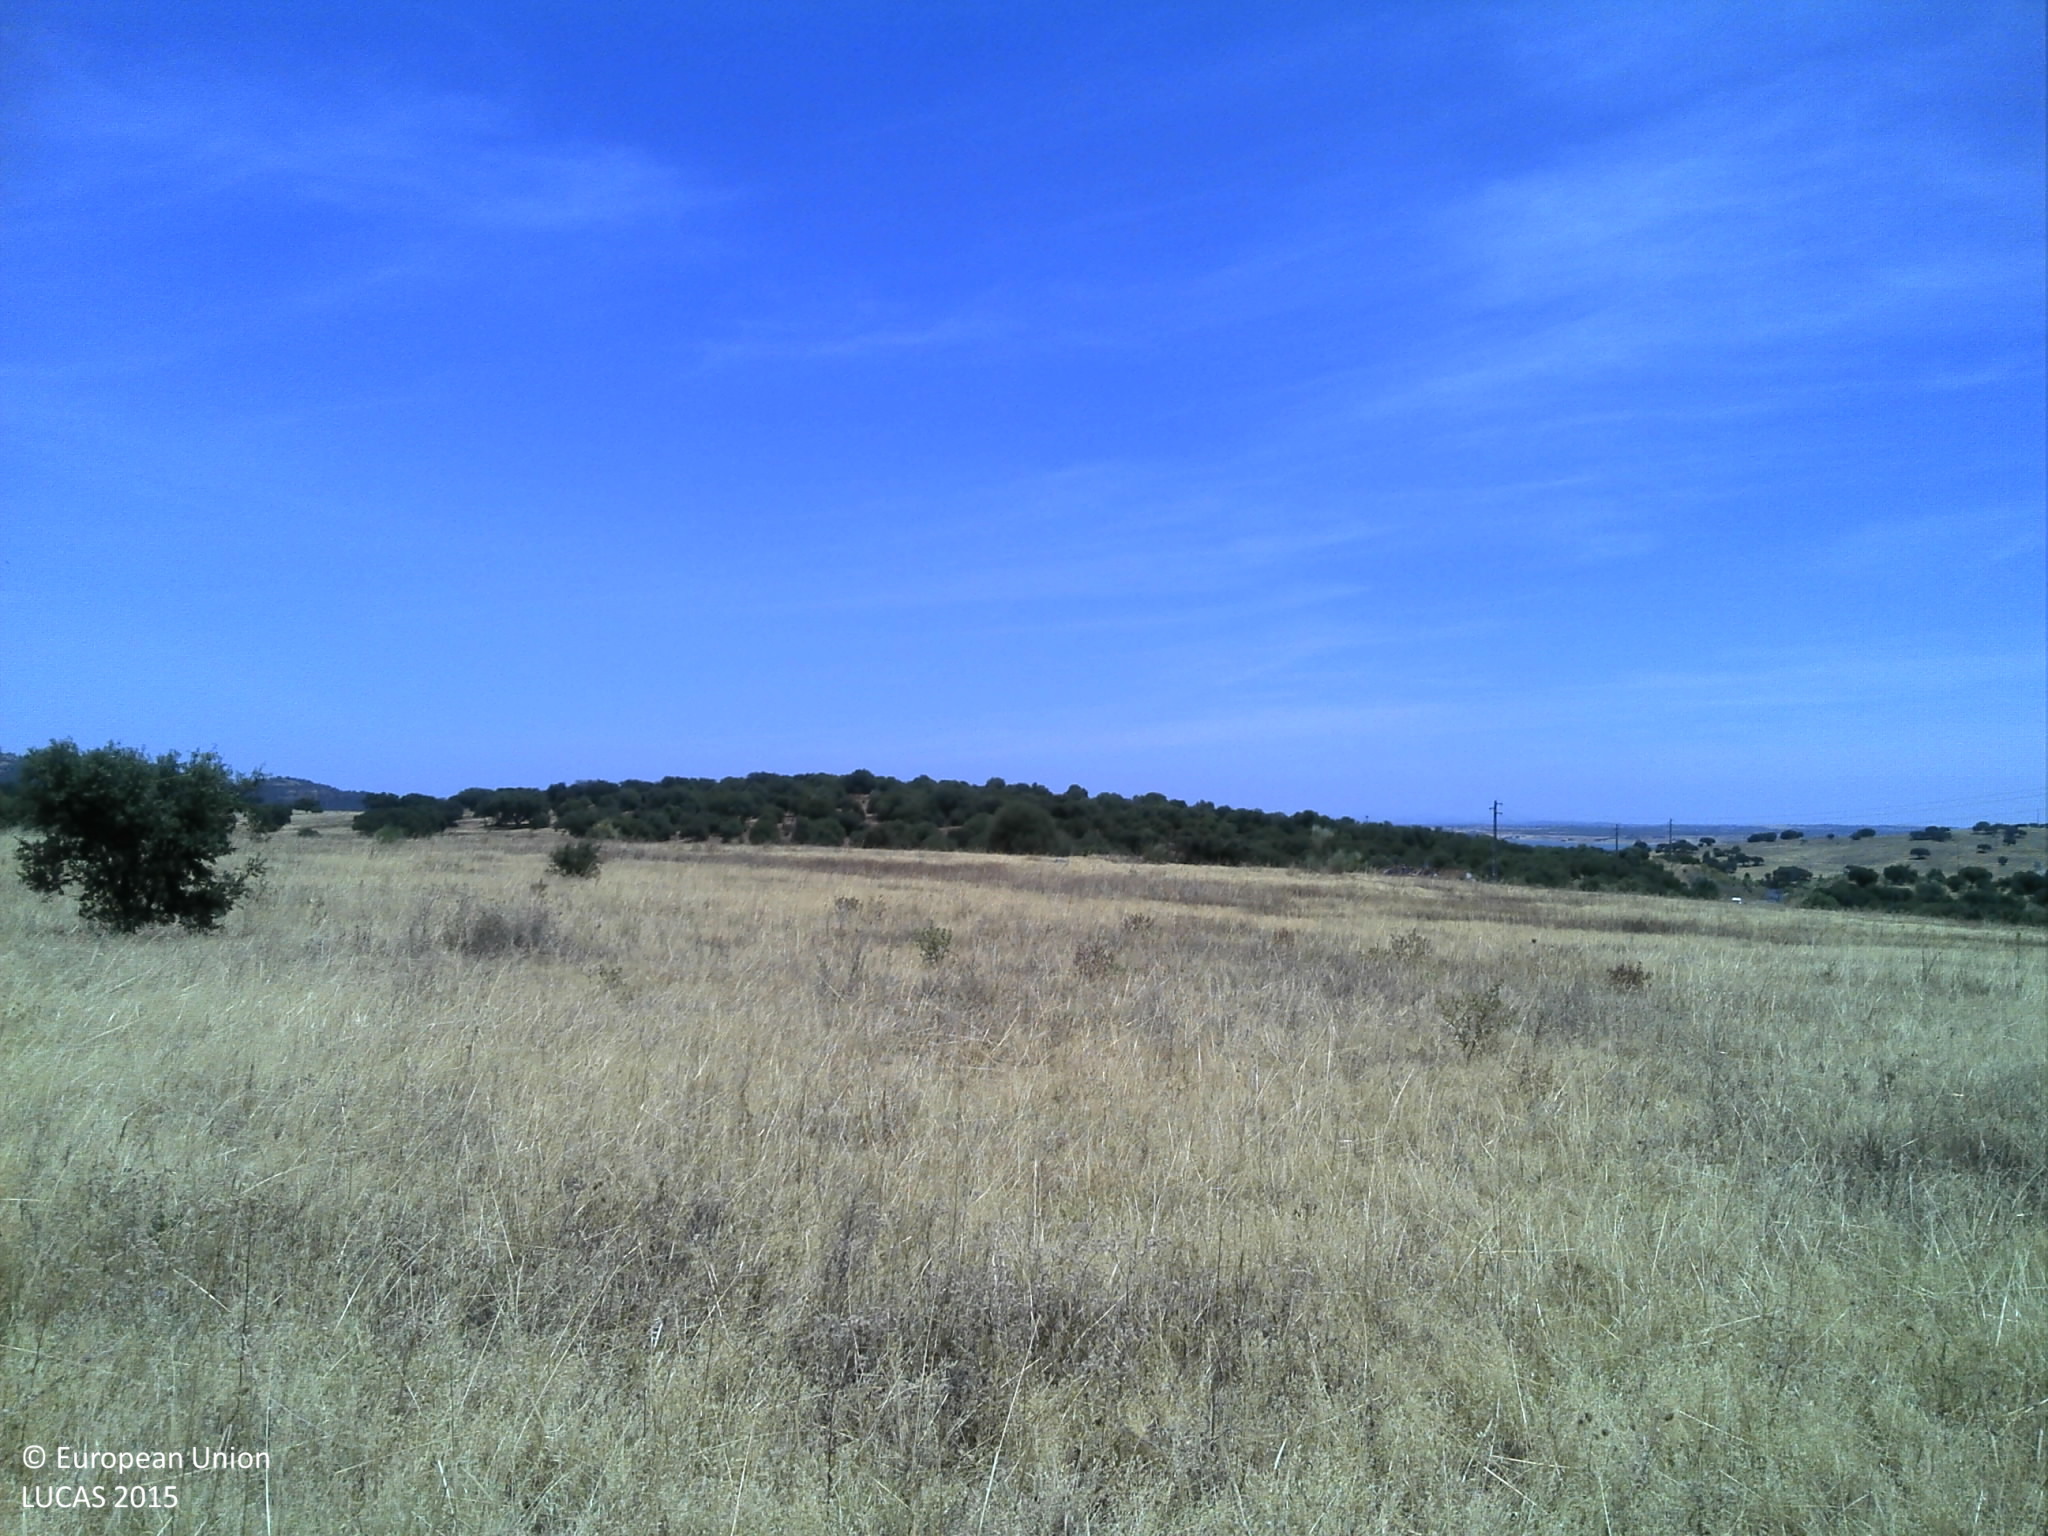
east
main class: Grassland
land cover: Grassland without tree/shrub cover
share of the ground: 25 - 50 %
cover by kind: herbaceous plants 50 %, unconsolidated bare surface 50 %
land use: Agriculture (excluding fallow land and kitchen gardens)
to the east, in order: Grassland without tree/shrub cover; Single bushes/trees
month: July
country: PT
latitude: 38.4178
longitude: -7.4229
